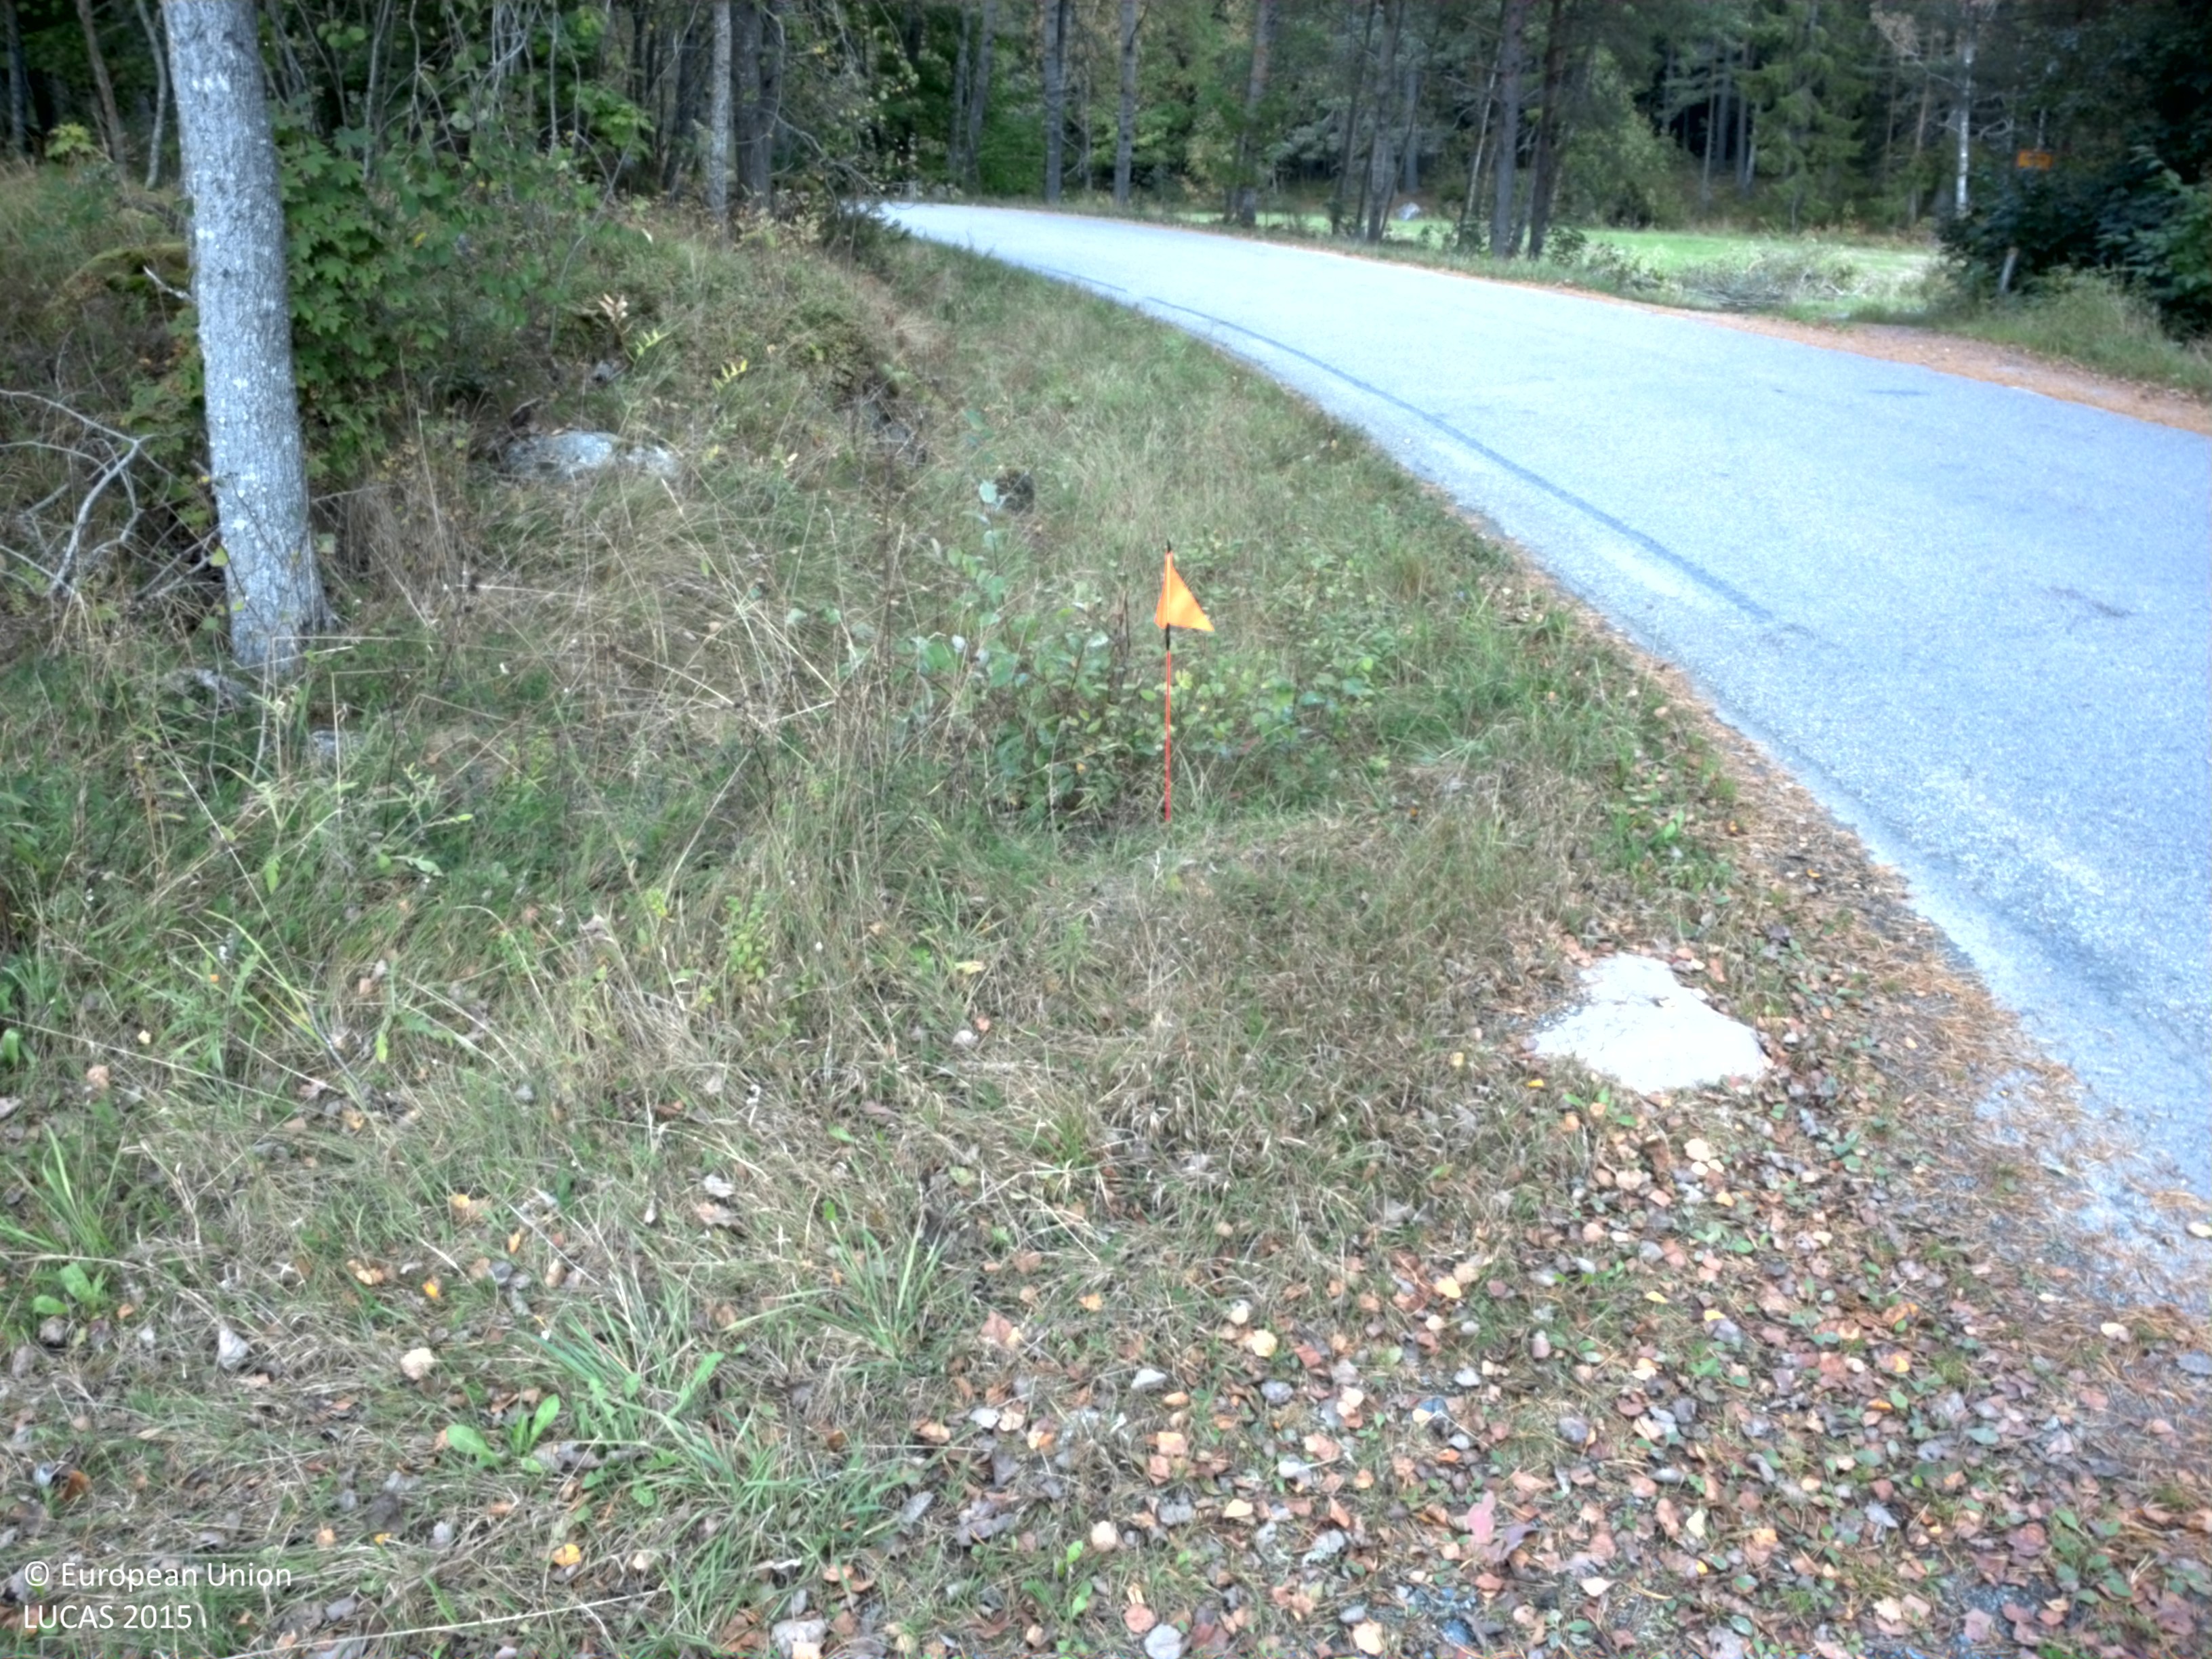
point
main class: Woodland
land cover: Broadleaved woodland
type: boreal forest
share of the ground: 50 - 75 %
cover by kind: broadleaved forest trees 75 %, herbaceous plants 25 %
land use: Forestry
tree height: > 5 m
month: September
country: SE
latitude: 59.8510
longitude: 18.8001
